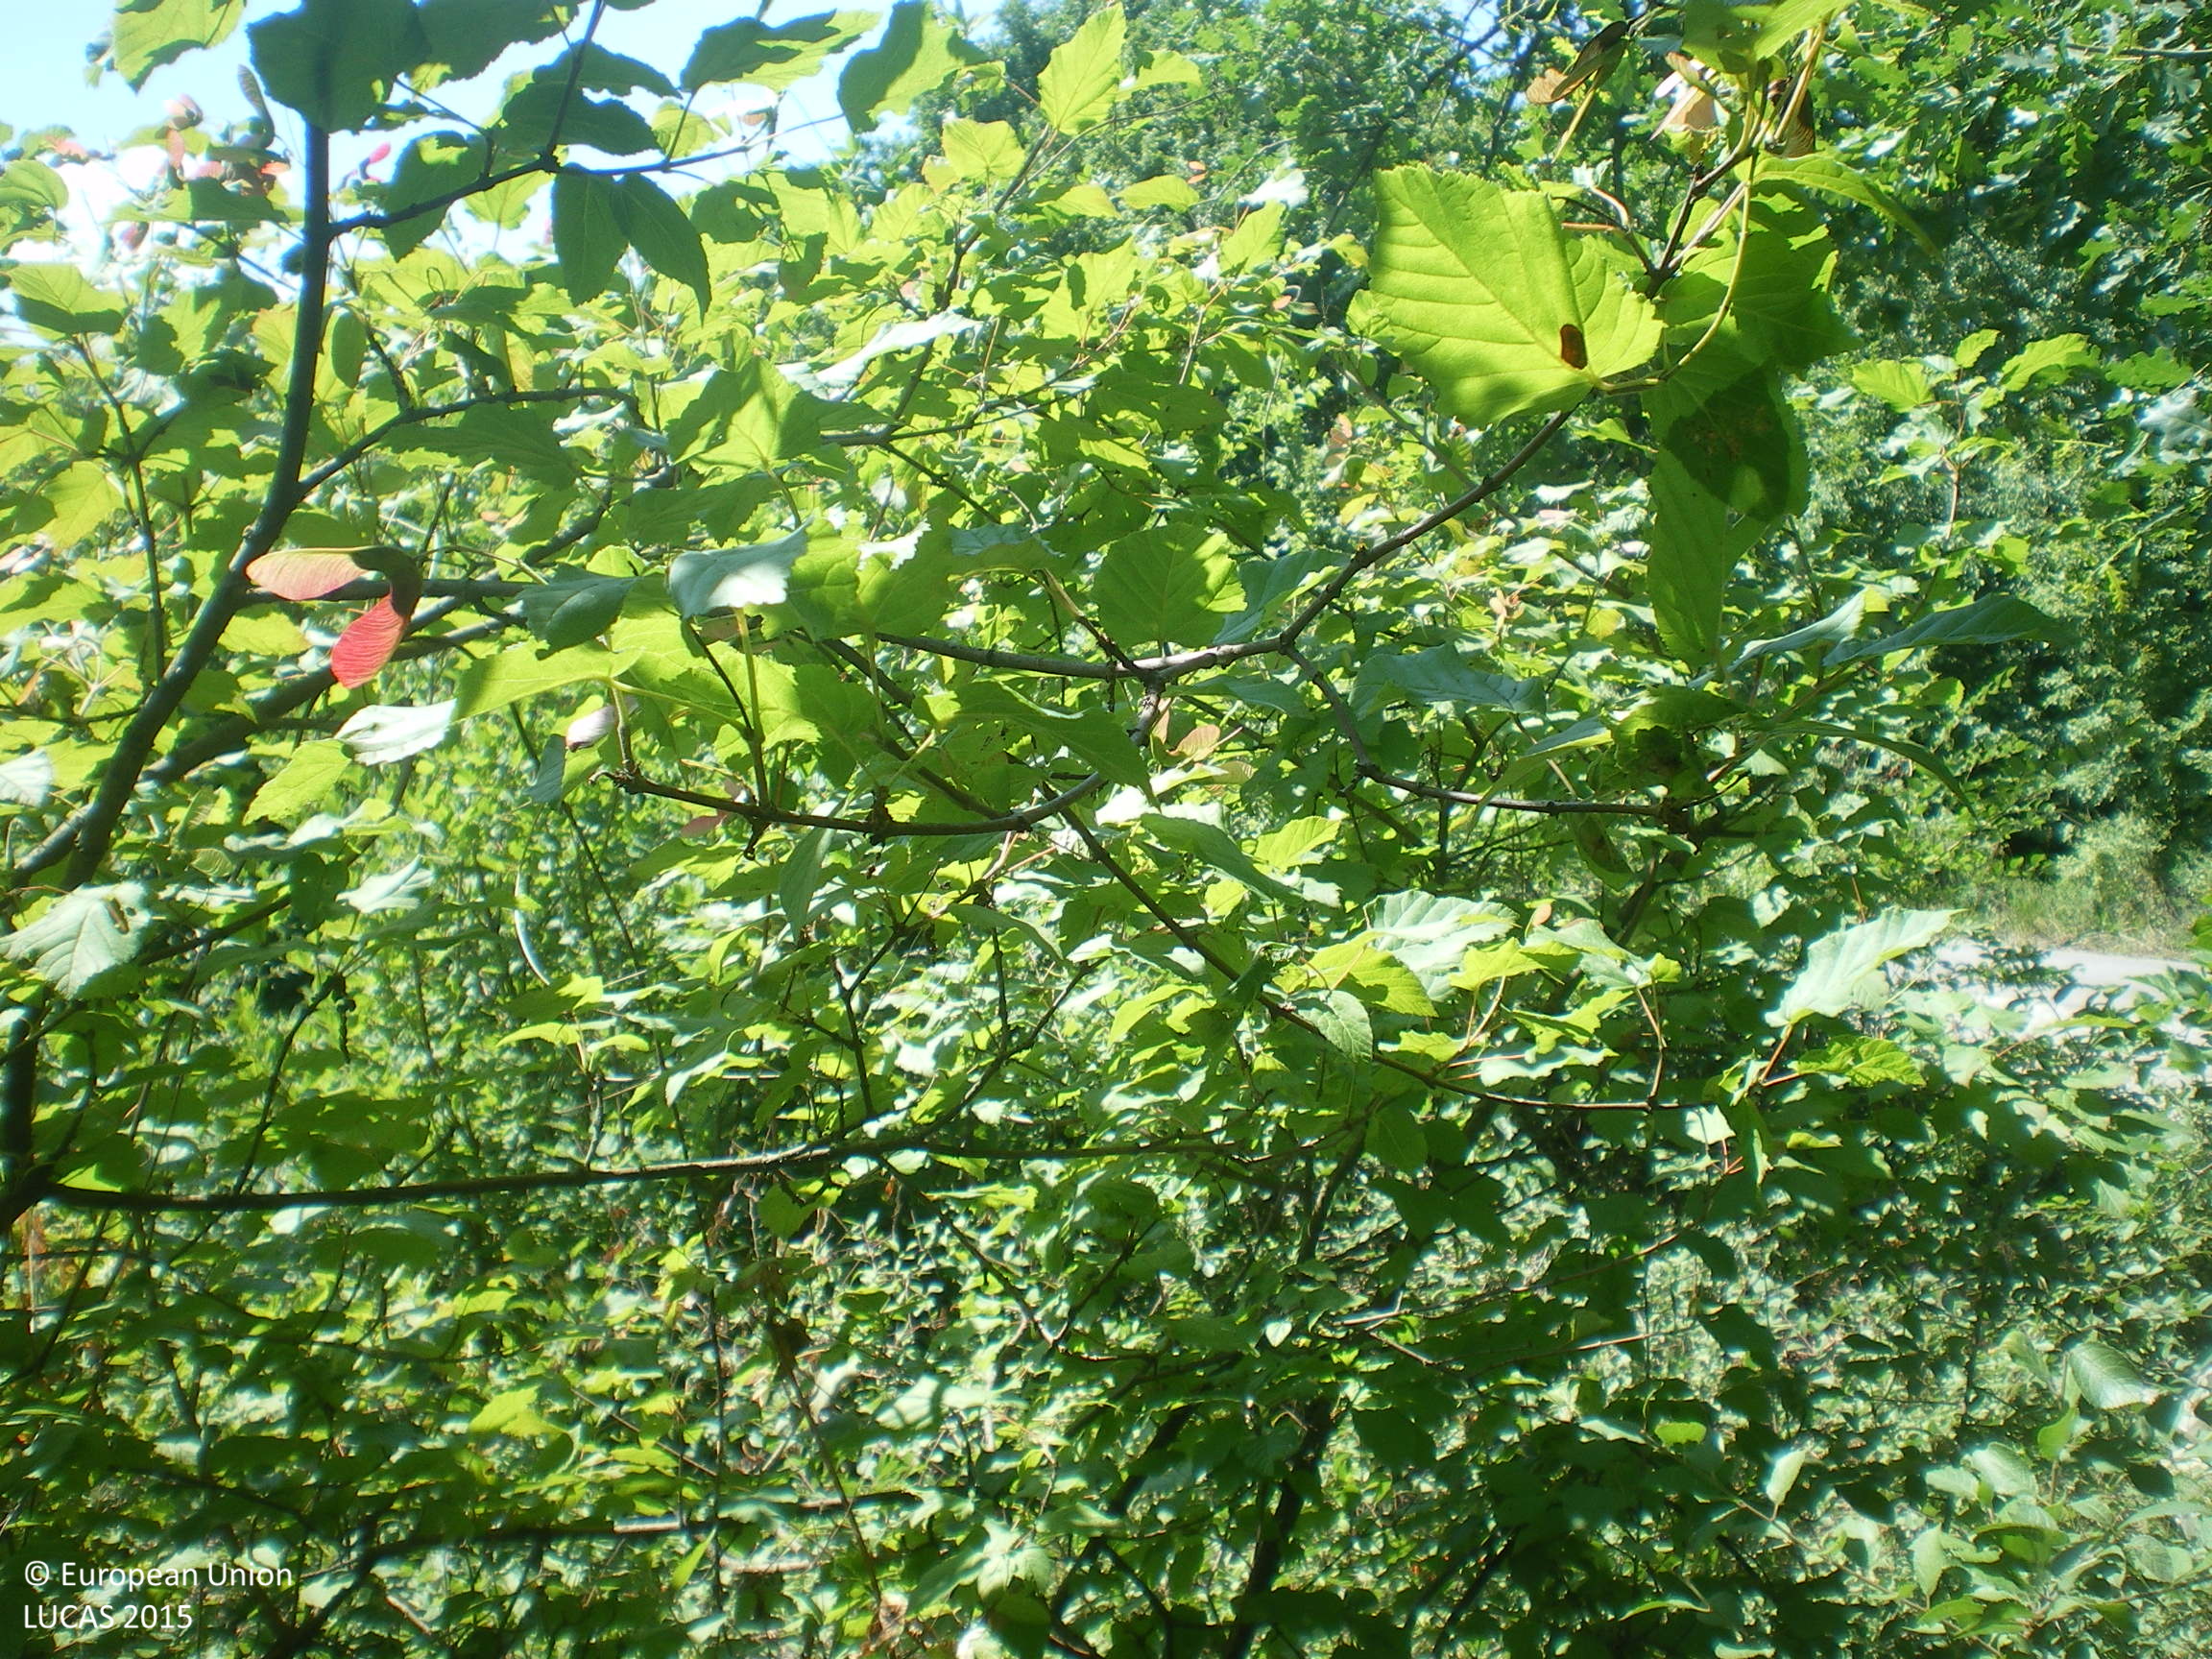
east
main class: Woodland
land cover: Broadleaved woodland
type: mesophytic deciduous forest
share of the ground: > 75 %
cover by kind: broadleaved forest trees 95 %, shrubs 5 %
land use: Forestry
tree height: > 5 m
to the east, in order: Broadleaved woodland; Spontaneously vegetated surfaces
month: July
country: BG
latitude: 42.4054
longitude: 25.8597
